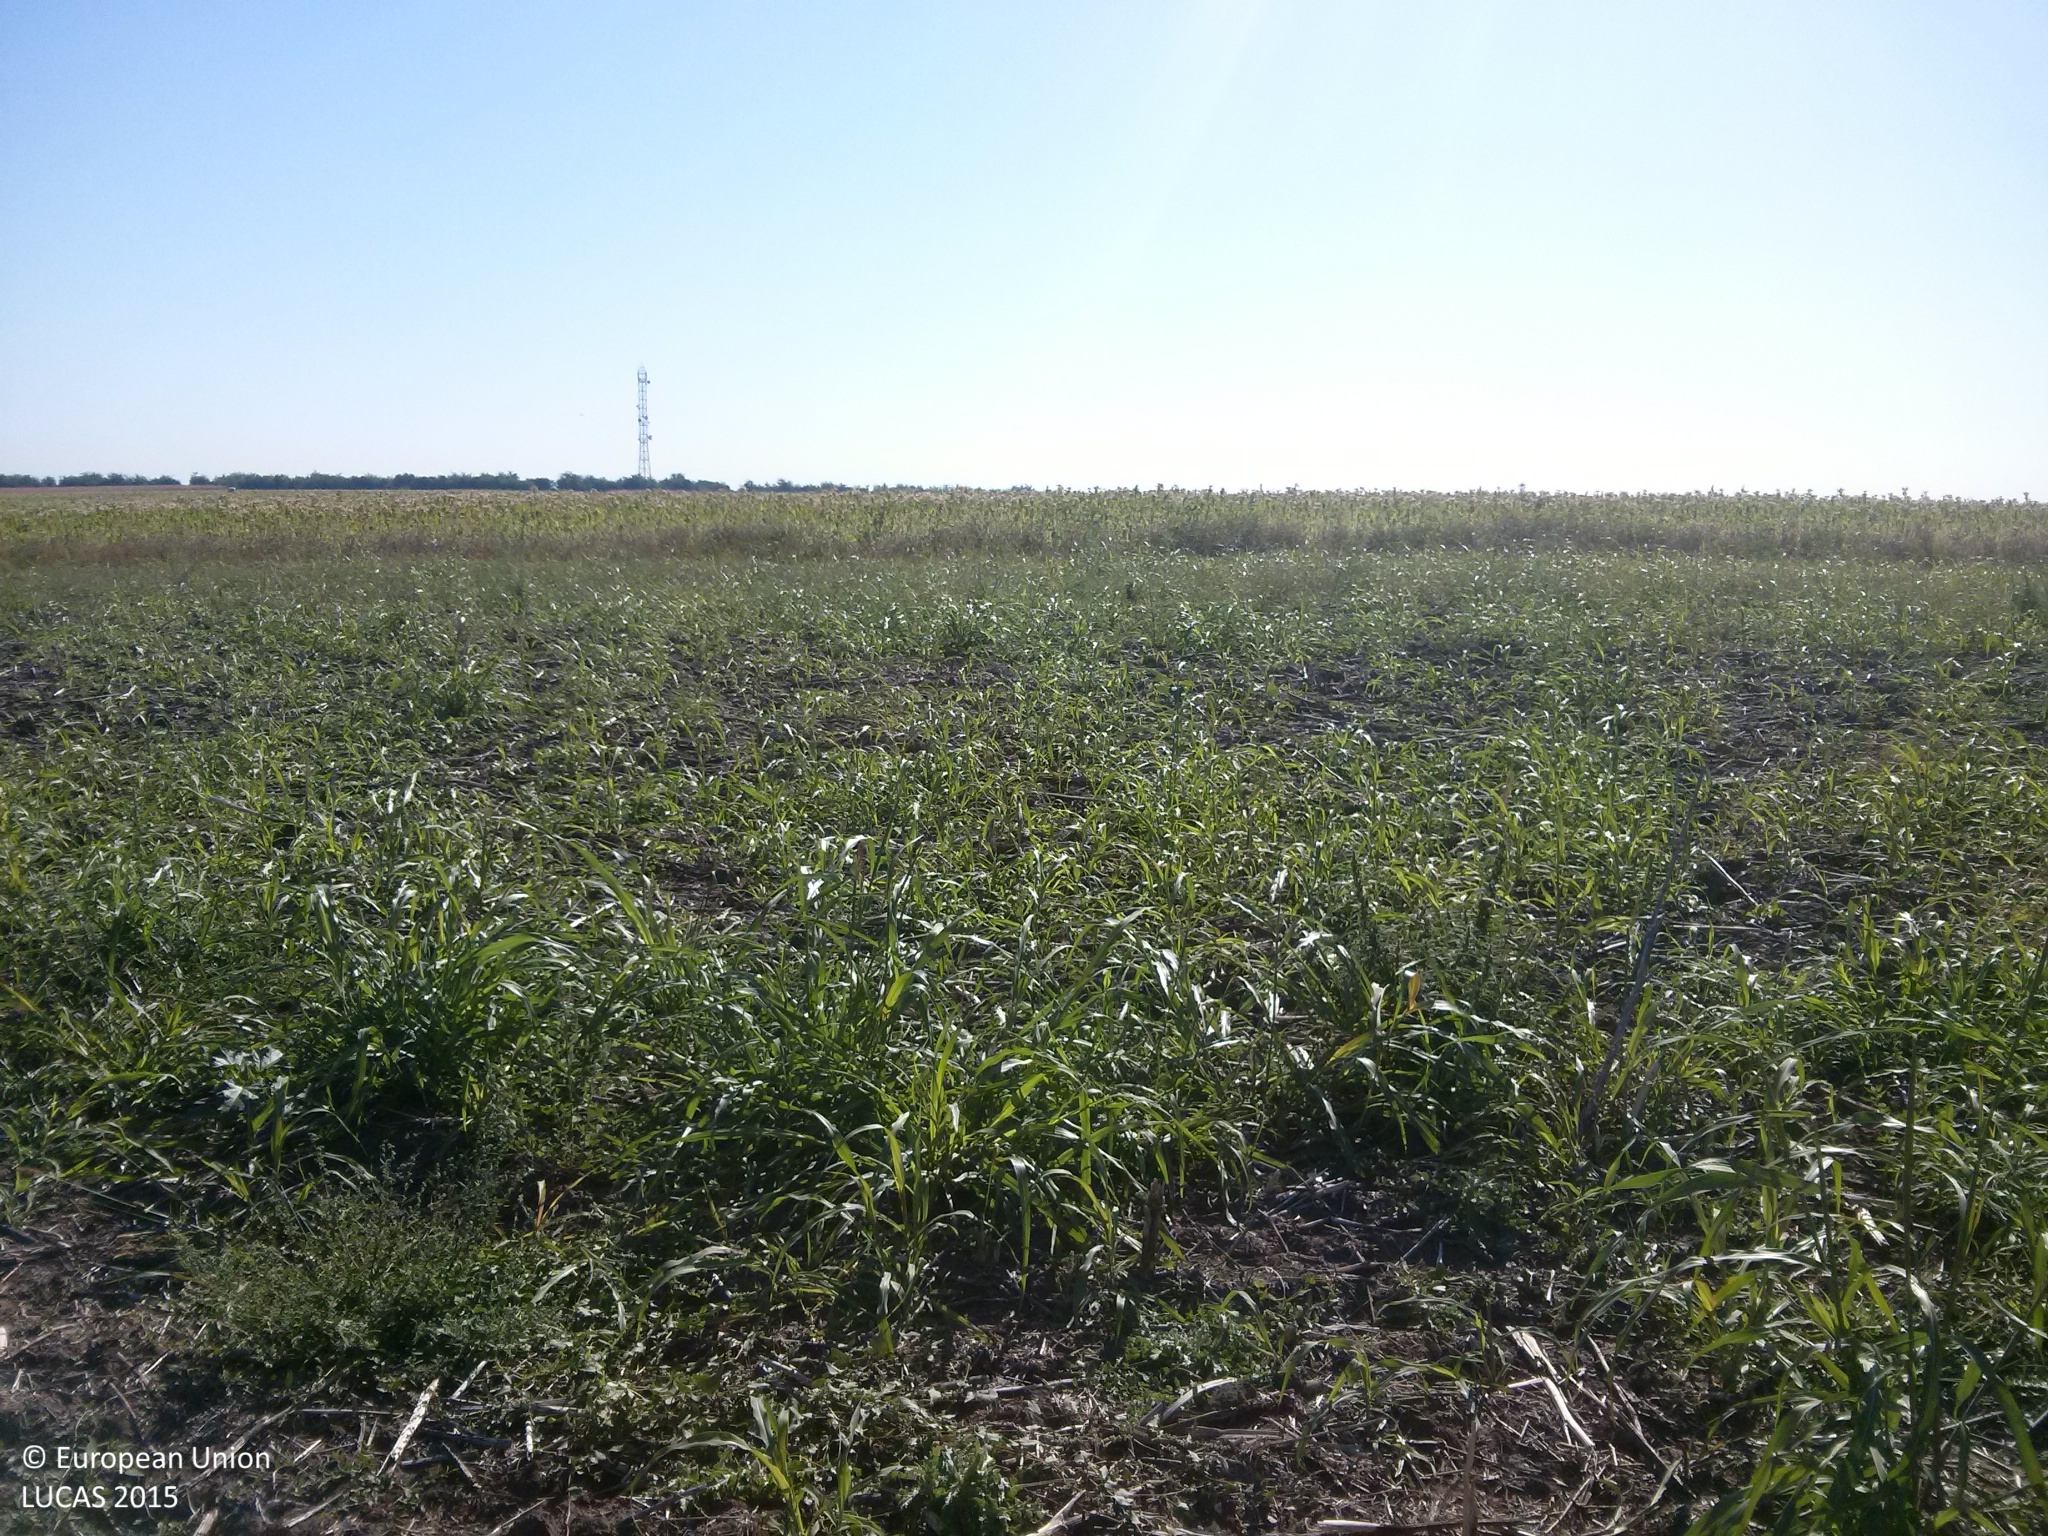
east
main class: Cropland
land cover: Rape and turnip rape
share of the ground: < 10 %
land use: Agriculture (excluding fallow land and kitchen gardens)
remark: Harvested field
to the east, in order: Rape and turnip rape; Grass margins; Tracks; Grass margins; Tobacco
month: September
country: BG
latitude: 43.7538
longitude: 26.3869
